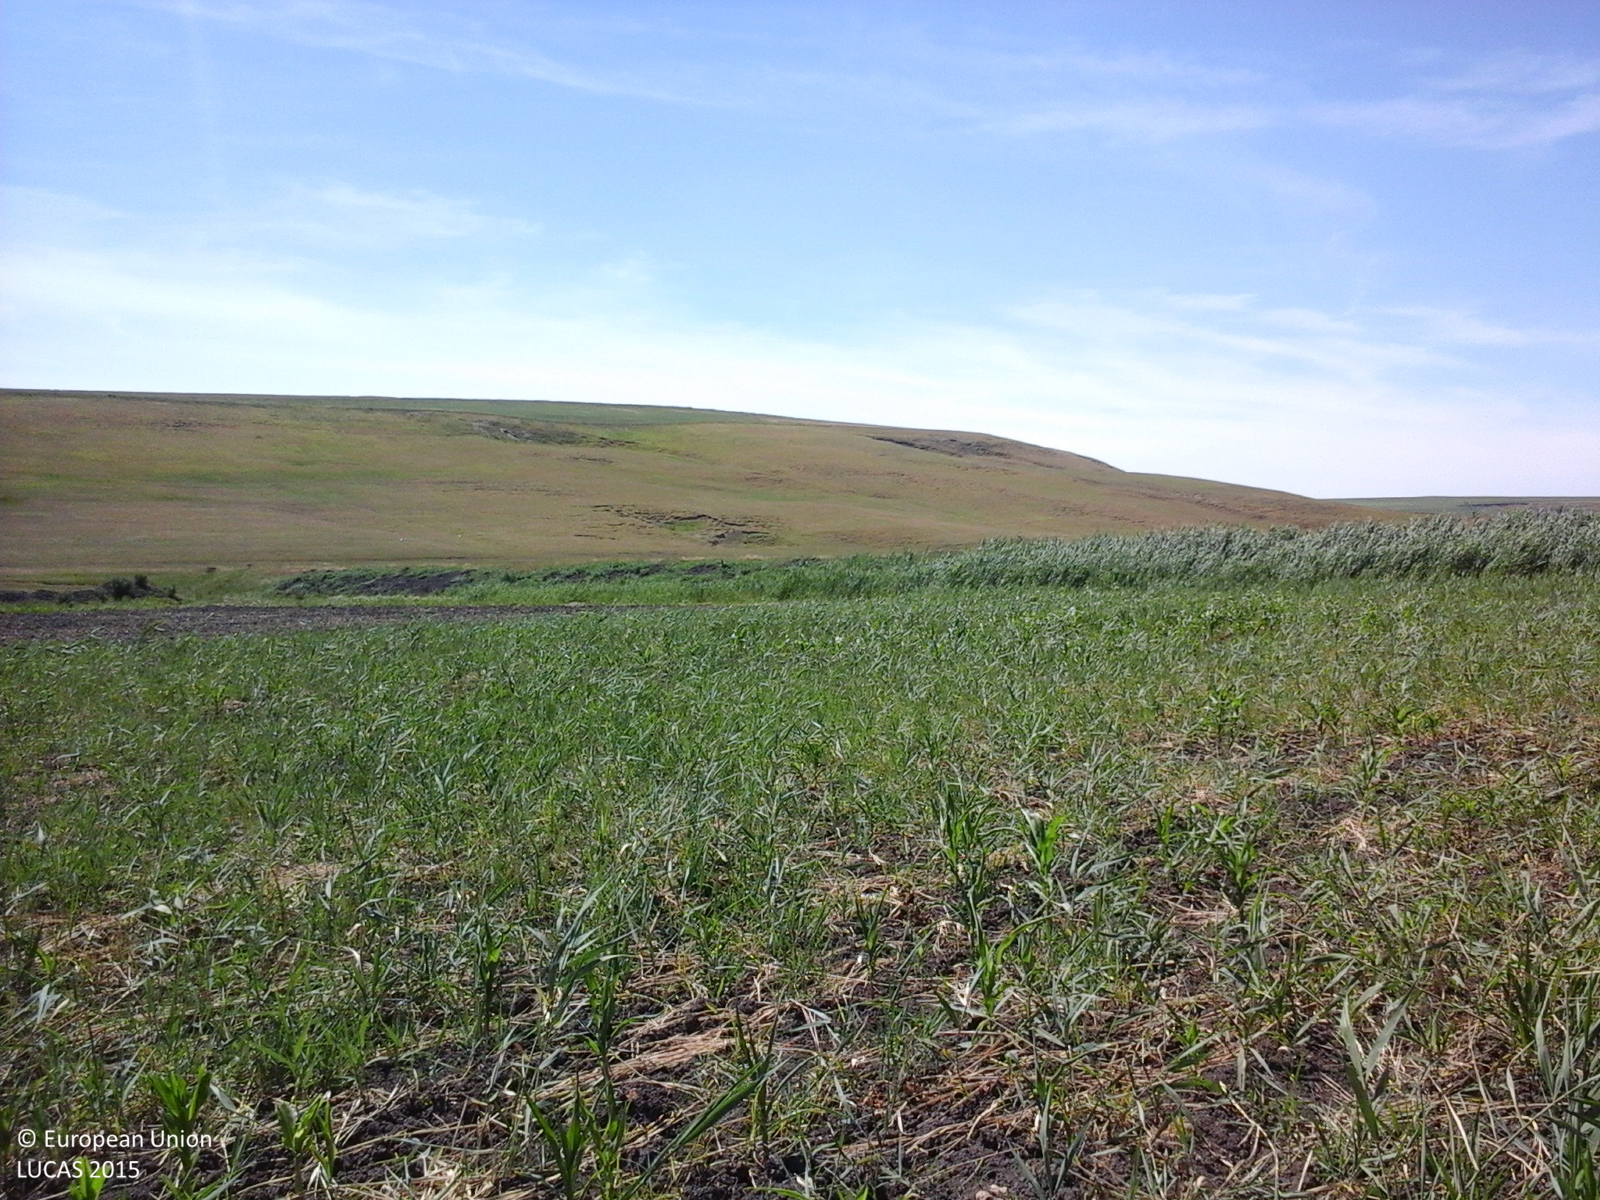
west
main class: Grassland
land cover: Spontaneously vegetated surfaces
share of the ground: > 75 %
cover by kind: herbaceous plants 100 %
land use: Agriculture (excluding fallow land and kitchen gardens)
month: June
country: RO
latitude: 47.2533
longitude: 27.0289
